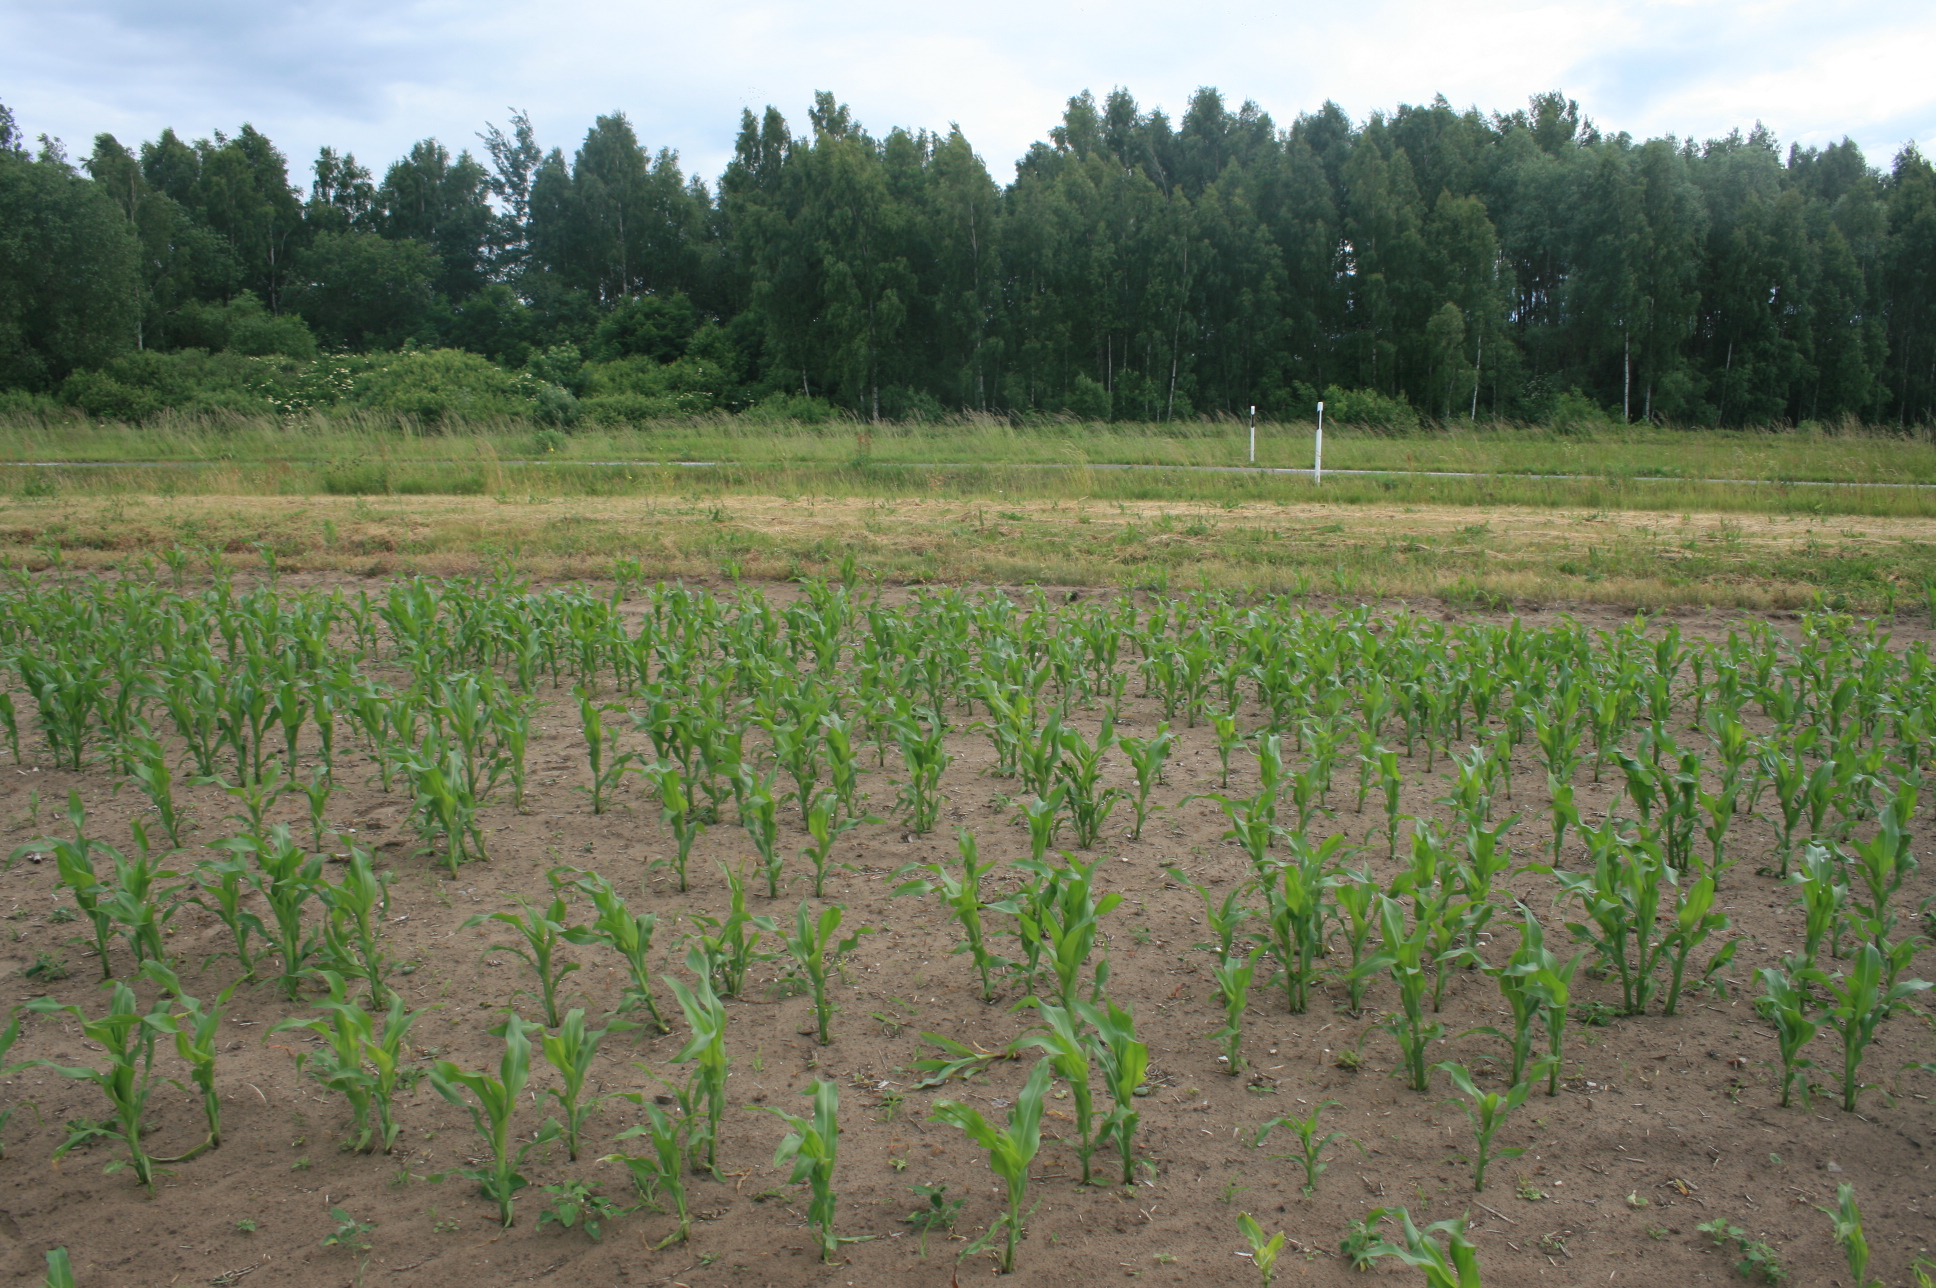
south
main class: Cropland
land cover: Maize
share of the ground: 50 - 75 %
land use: Agriculture (excluding fallow land and kitchen gardens)
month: June
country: LT
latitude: 55.1112
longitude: 22.0156
